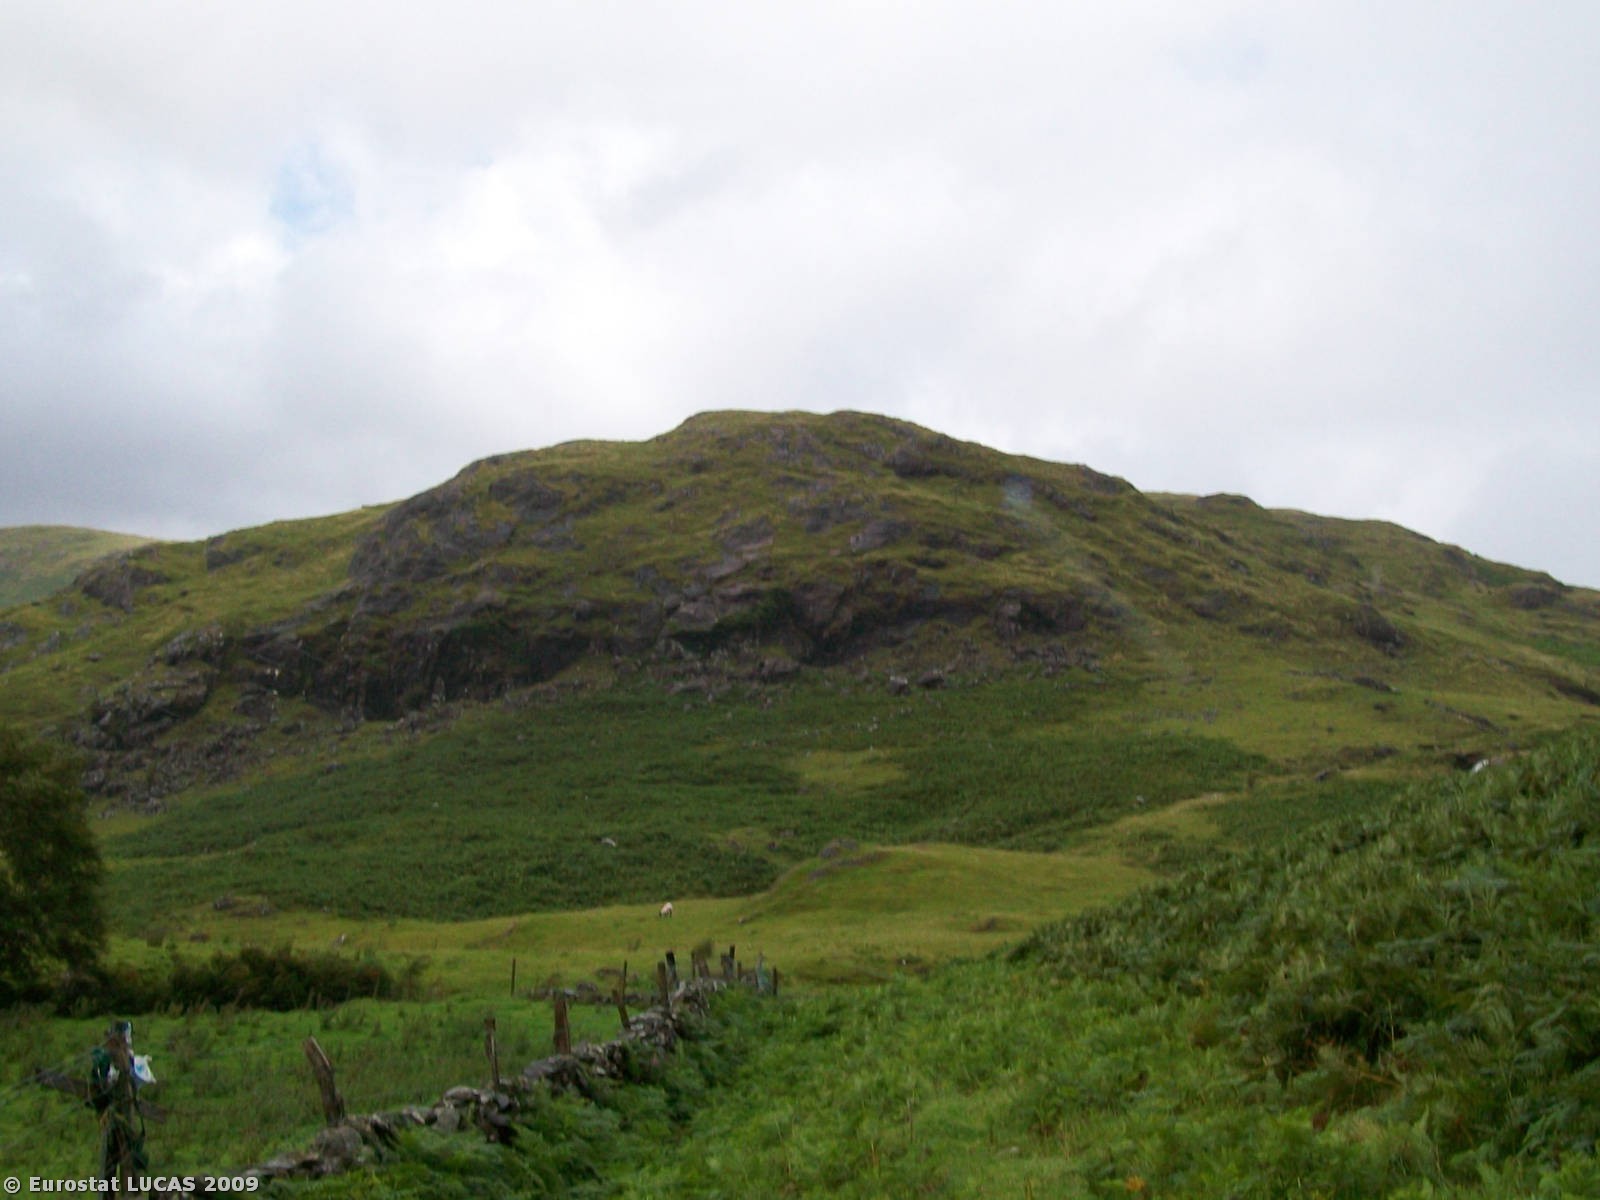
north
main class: Grassland
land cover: Grassland without tree/shrub cover
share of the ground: > 75 %
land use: Agriculture (excluding fallow land and kitchen gardens)
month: July
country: IE
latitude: 53.5749
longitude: -9.4871
